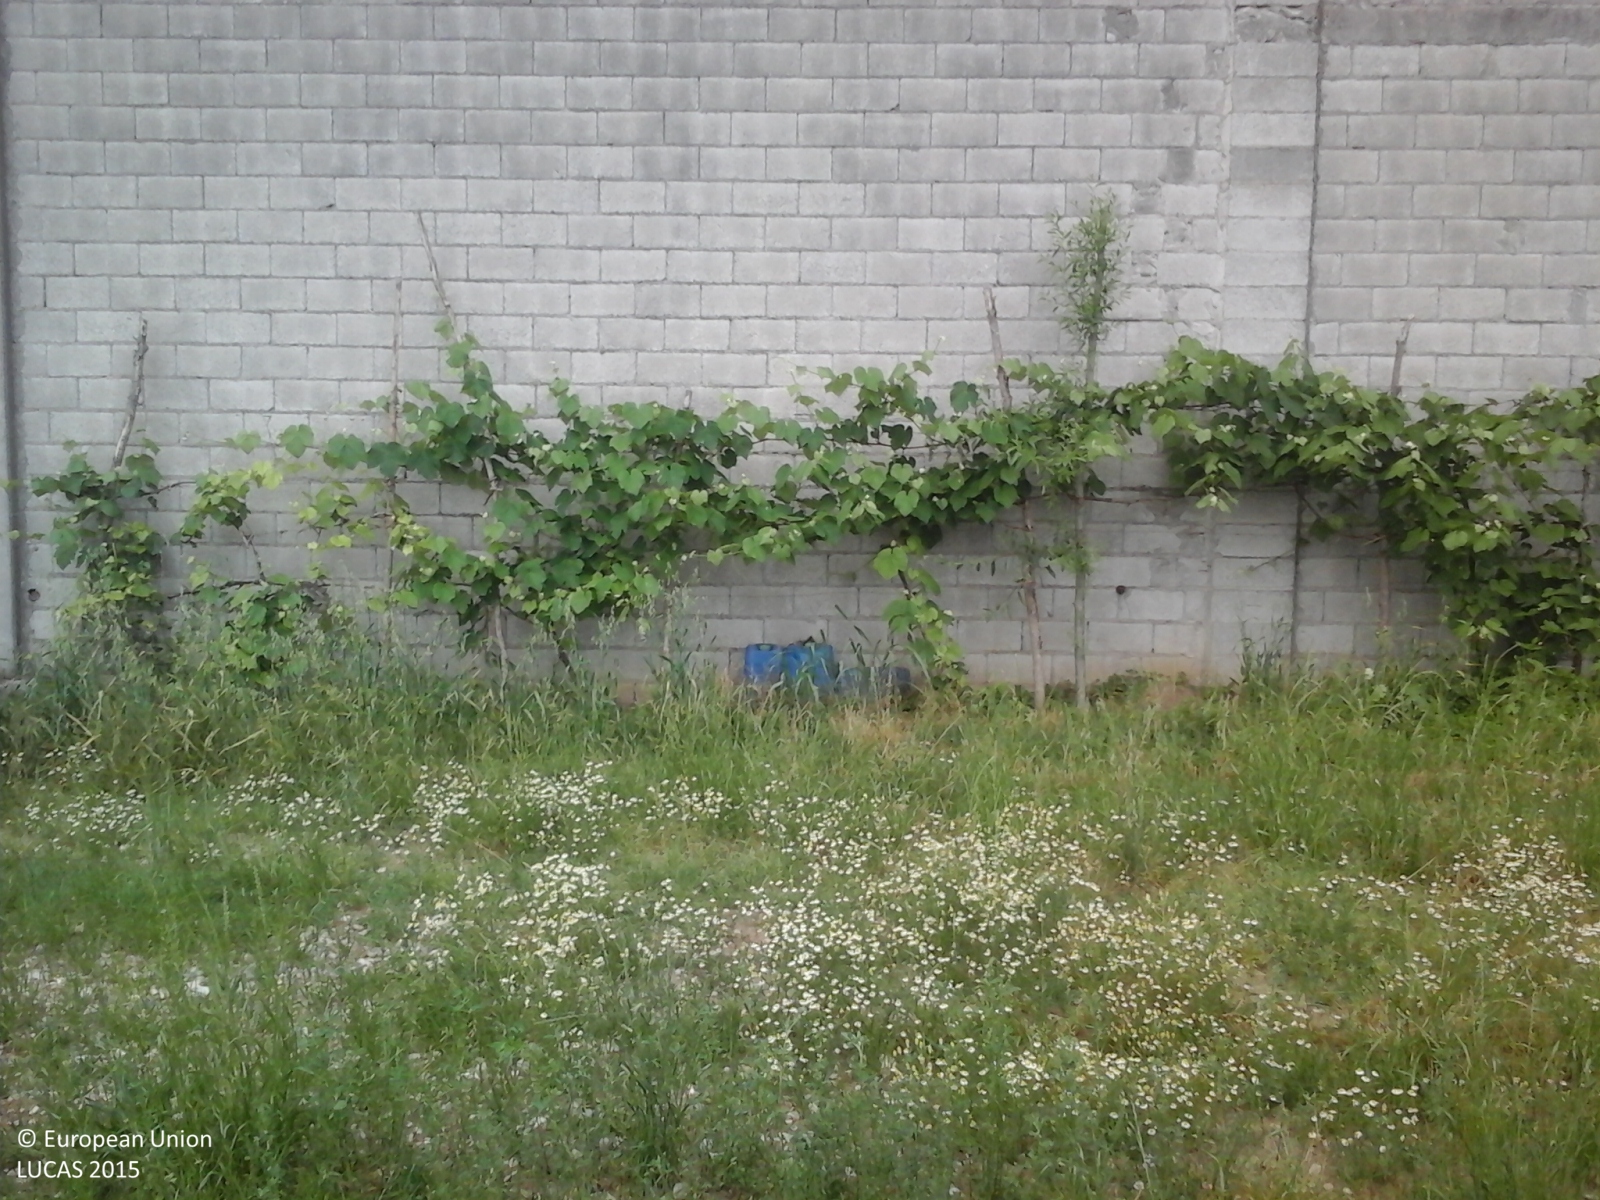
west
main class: Cropland
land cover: Lucerne
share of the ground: > 75 %
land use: Agriculture (excluding fallow land and kitchen gardens)
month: May
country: IT
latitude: 45.1962
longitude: 10.6226
